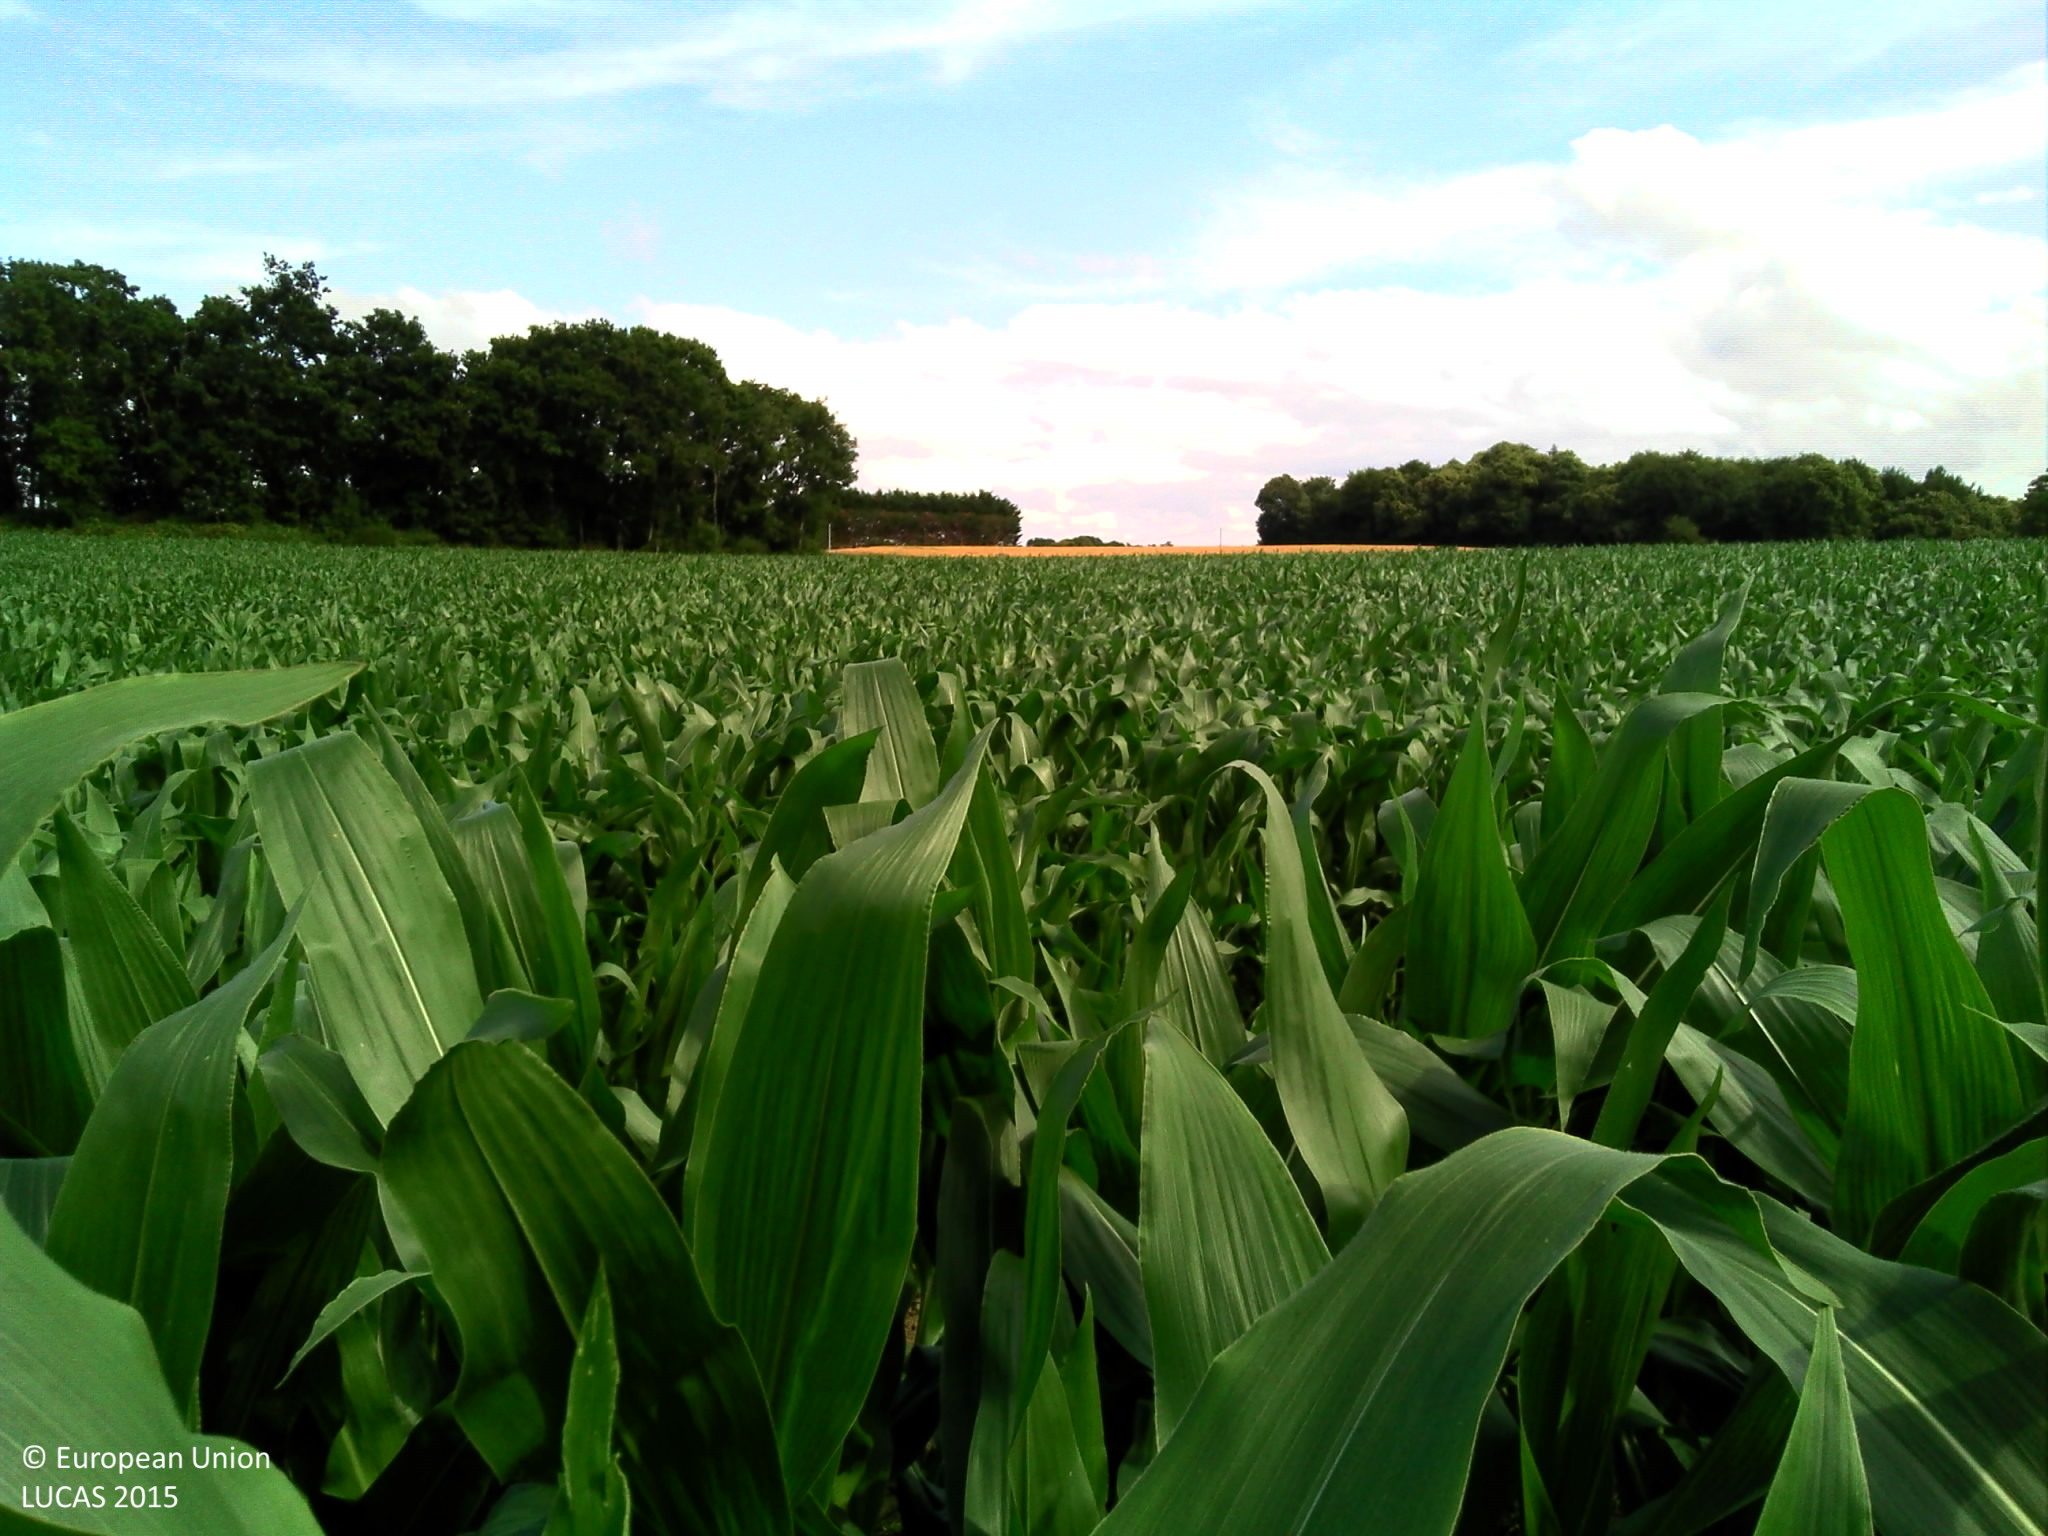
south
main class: Cropland
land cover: Maize
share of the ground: > 75 %
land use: Agriculture (excluding fallow land and kitchen gardens)
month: July
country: FR
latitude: 48.4750
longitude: -1.9983
